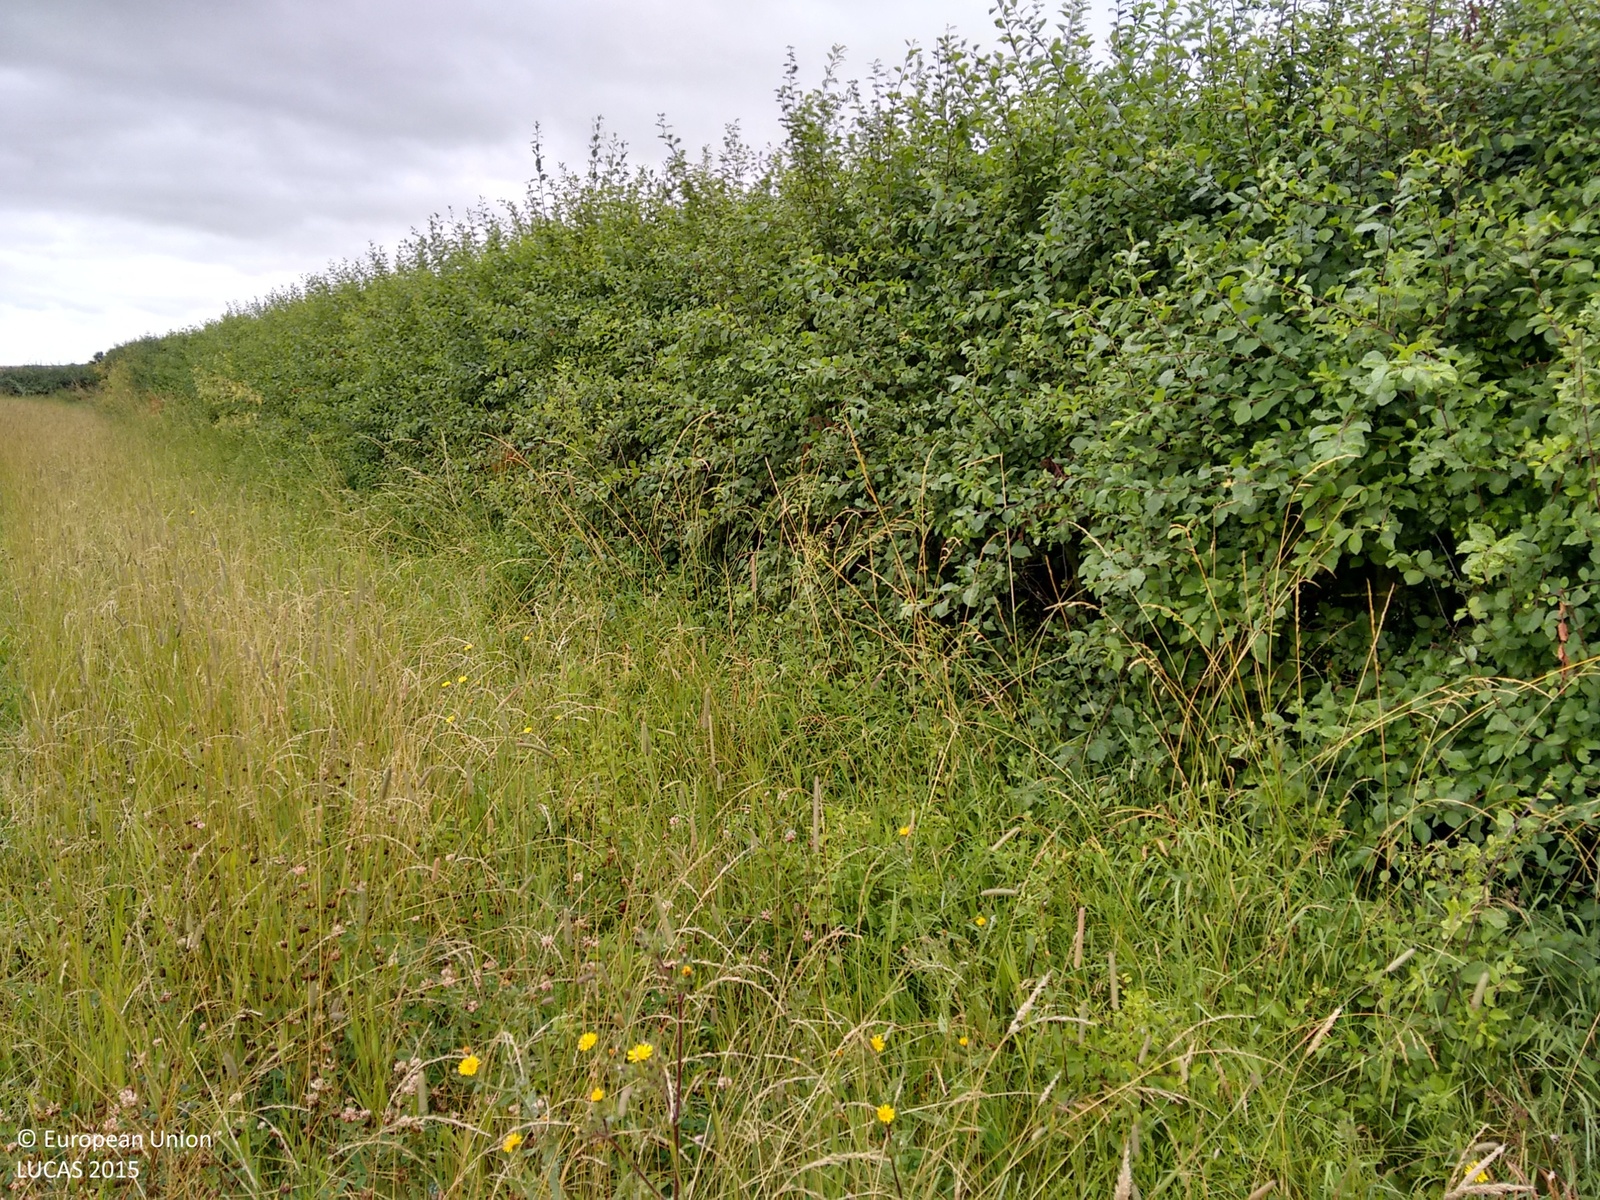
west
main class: Grassland
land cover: Grassland without tree/shrub cover
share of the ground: > 75 %
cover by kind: herbaceous plants 100 %
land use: Agriculture (excluding fallow land and kitchen gardens)
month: July
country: GB
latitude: 52.9561
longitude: -0.7735
